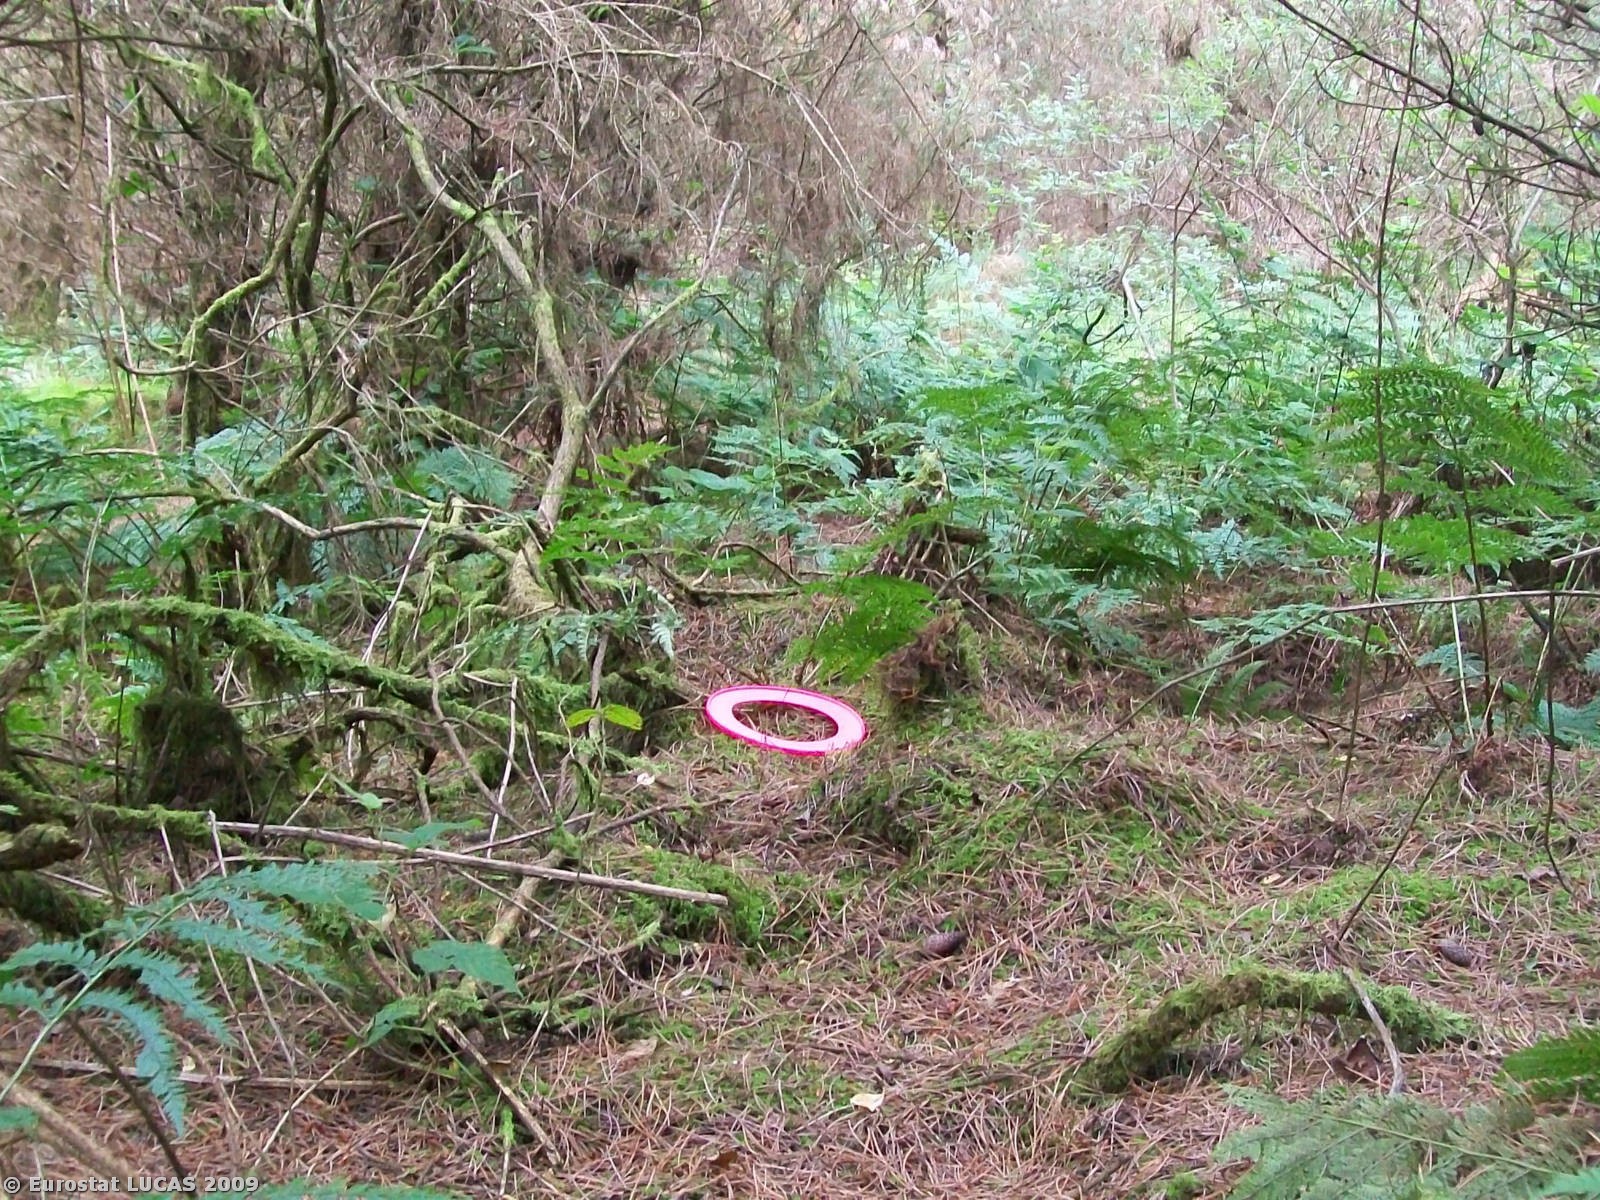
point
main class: Woodland
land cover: Coniferous woodland
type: plantations and self-sown exotic forest
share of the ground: > 75 %
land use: Forestry
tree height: > 5 m
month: July
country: GB
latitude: 55.2061
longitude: -6.3173
